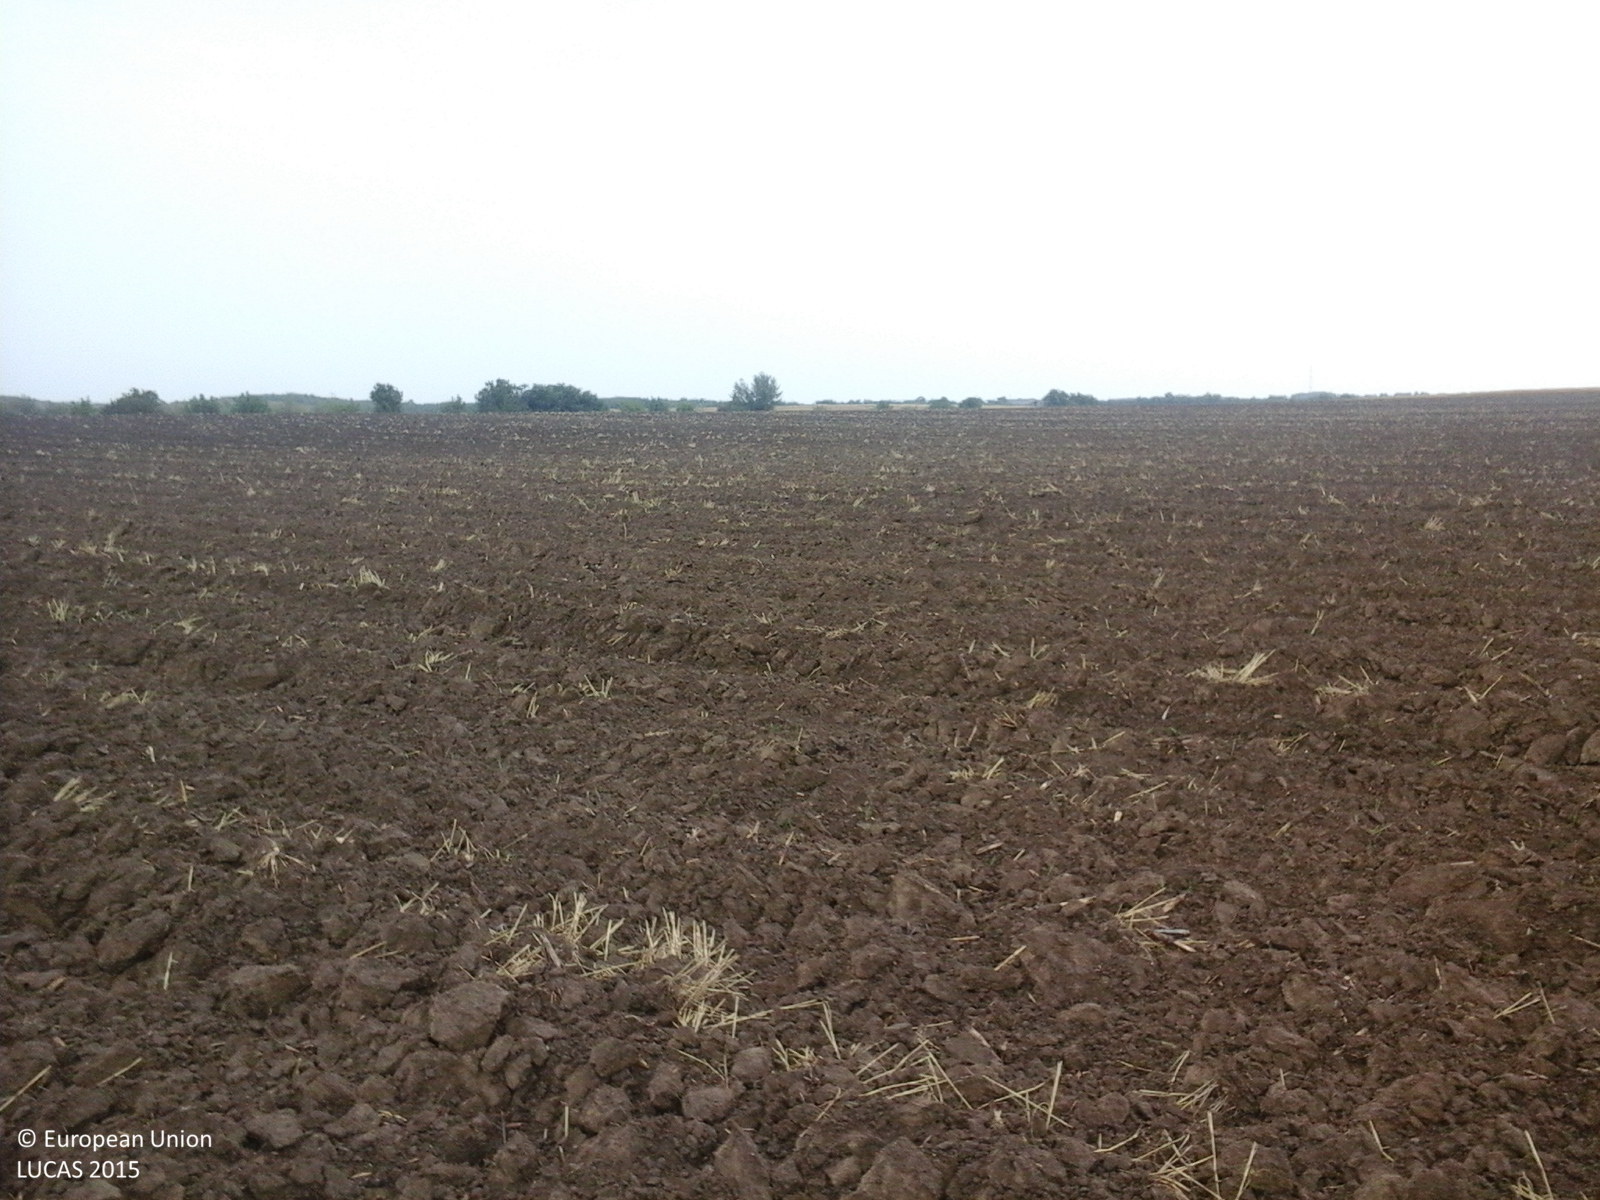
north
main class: Cropland
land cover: Common wheat
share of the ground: < 10 %
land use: Agriculture (excluding fallow land and kitchen gardens)
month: September
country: RO
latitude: 47.6216
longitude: 22.3094
